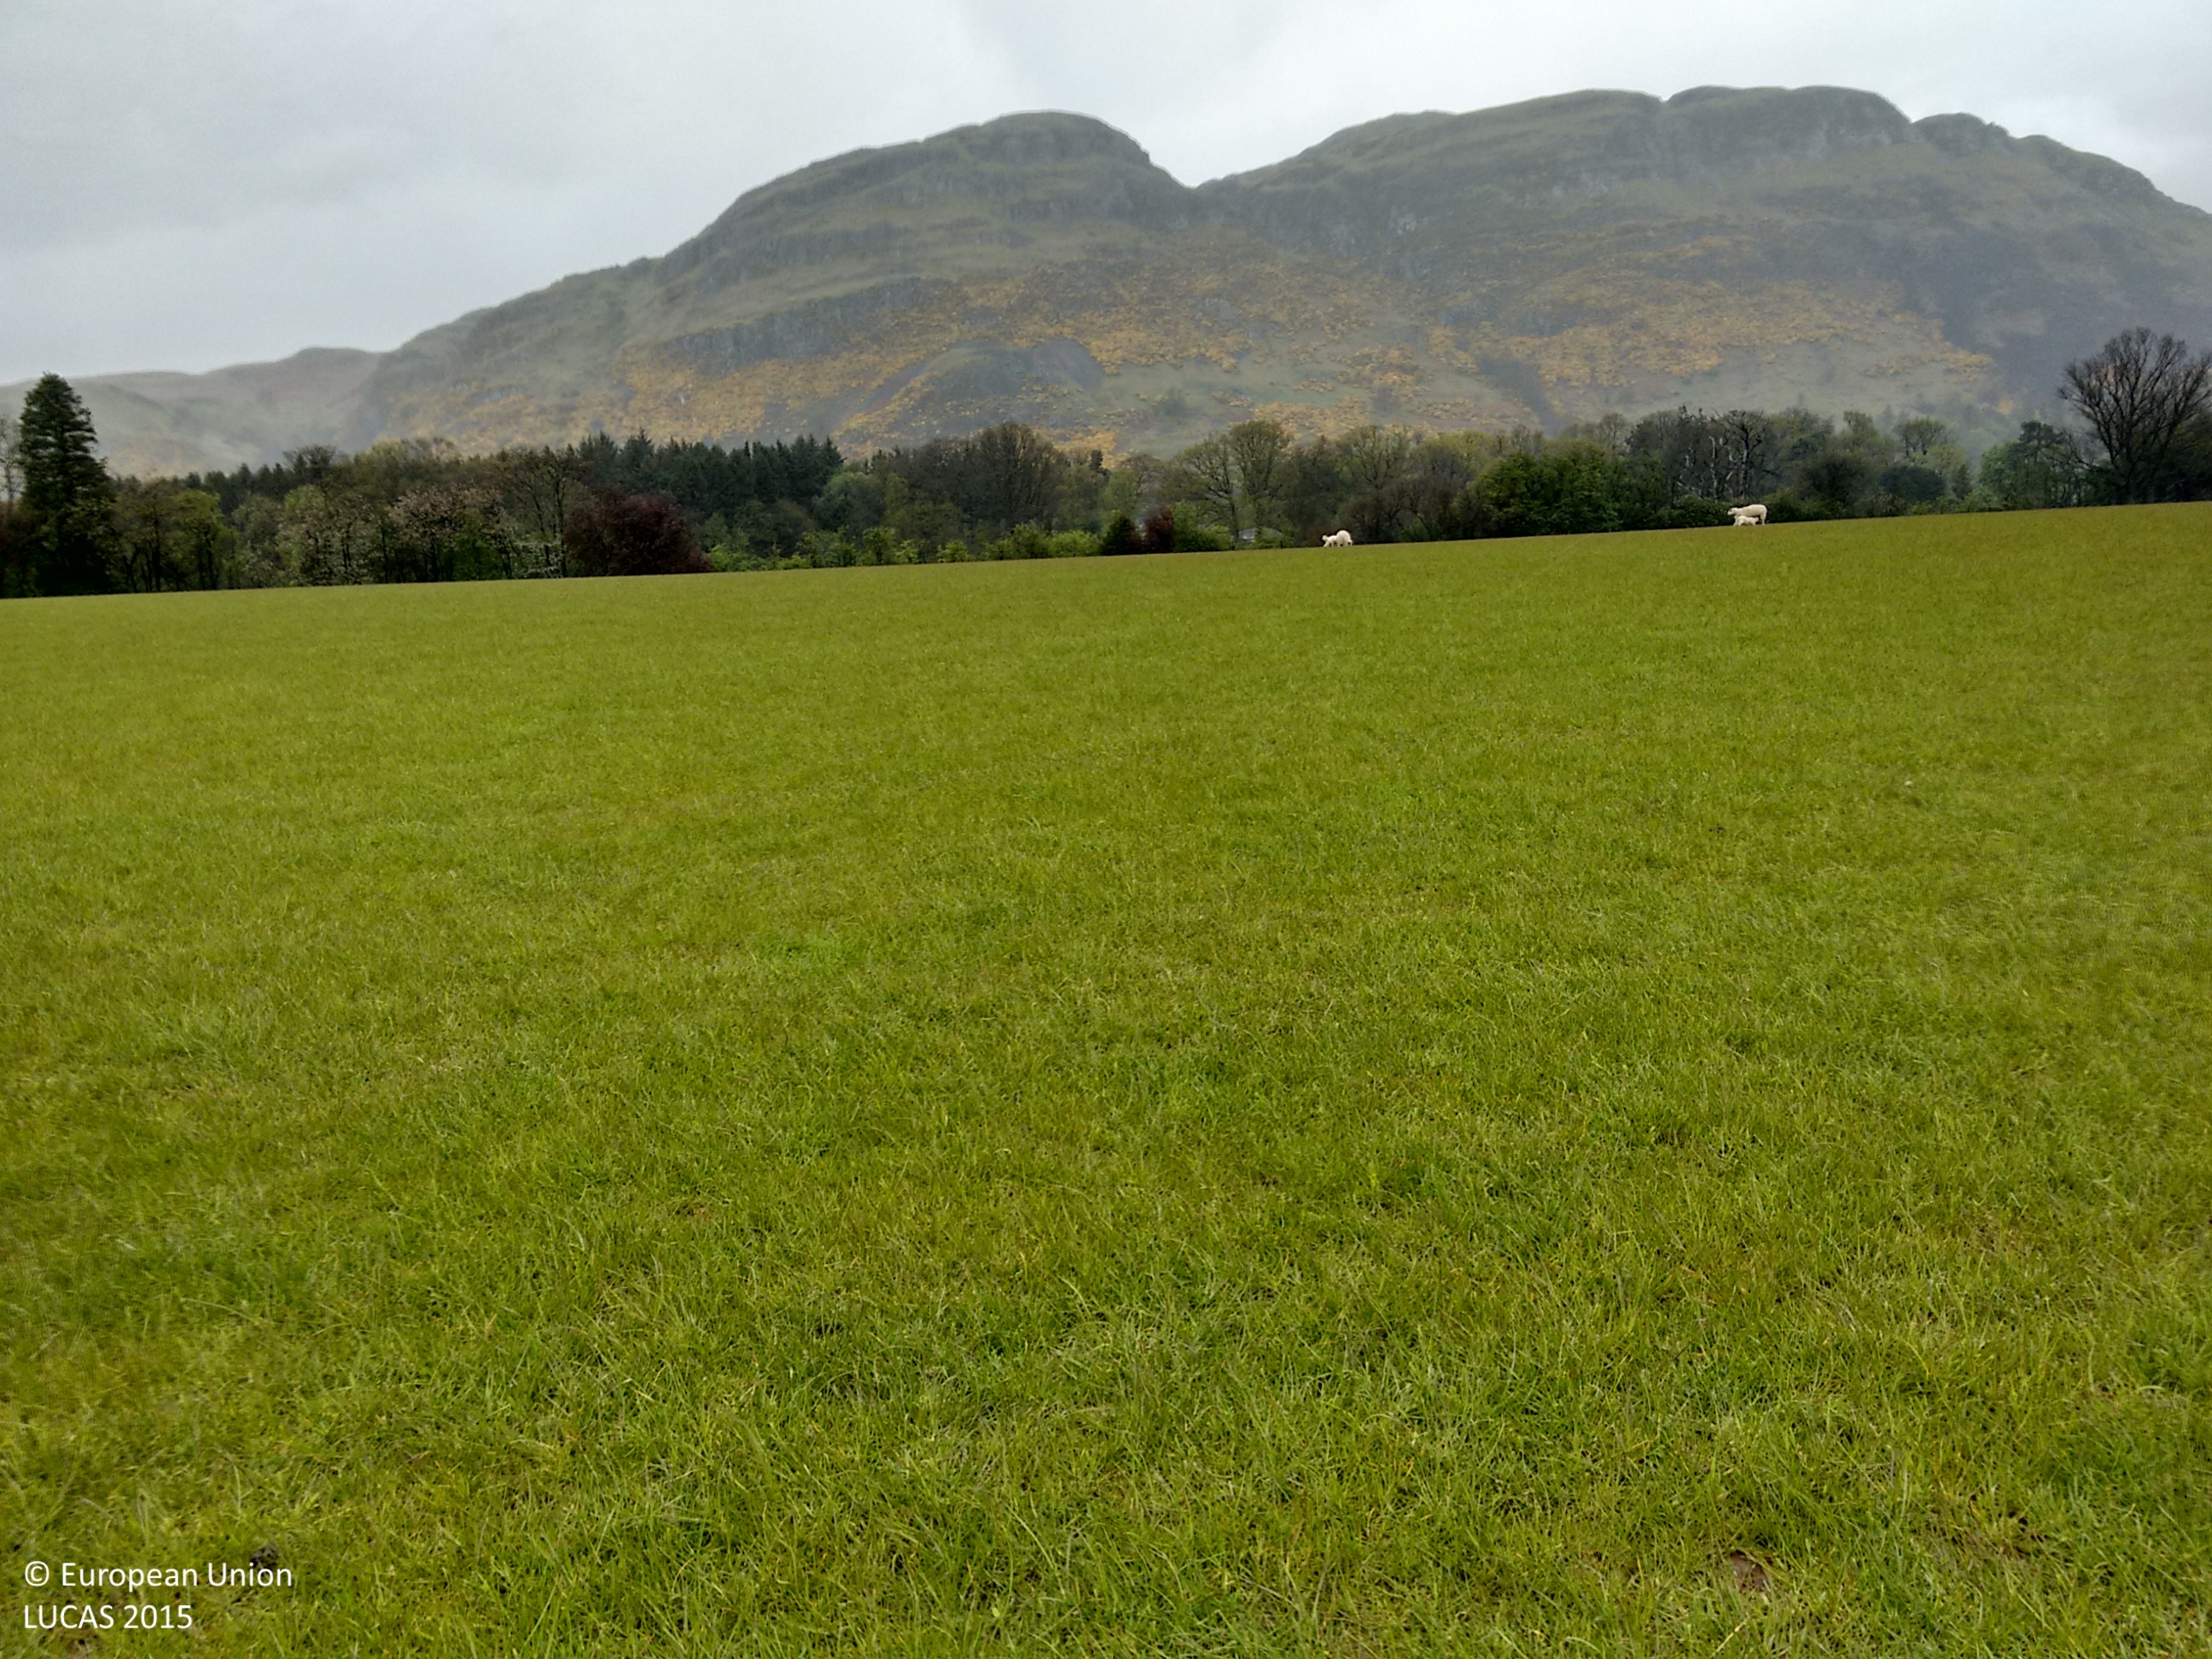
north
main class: Grassland
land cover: Grassland without tree/shrub cover
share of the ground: > 75 %
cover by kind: herbaceous plants 100 %
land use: Agriculture (excluding fallow land and kitchen gardens)
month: May
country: GB
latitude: 56.1416
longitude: -3.8764
